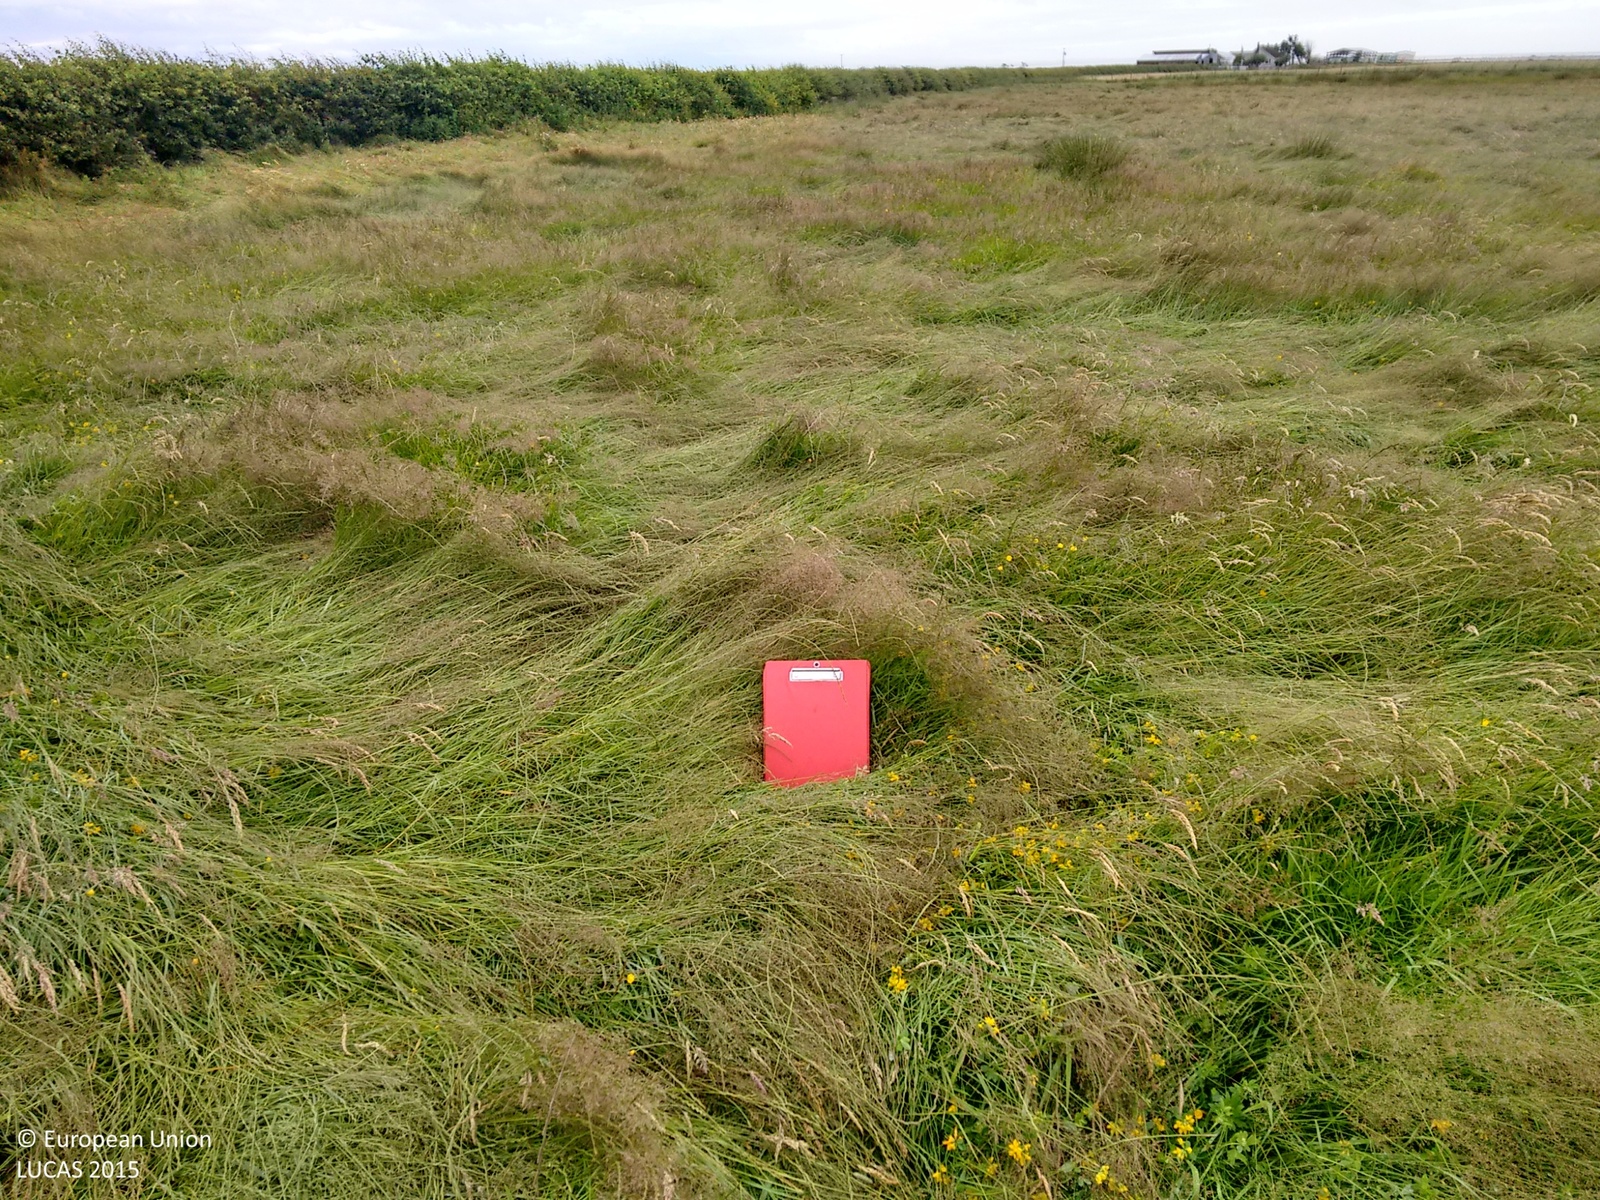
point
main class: Grassland
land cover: Grassland without tree/shrub cover
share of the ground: > 75 %
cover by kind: herbaceous plants 100 %
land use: Agriculture (excluding fallow land and kitchen gardens)
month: July
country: GB
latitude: 54.9868
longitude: -3.4095
